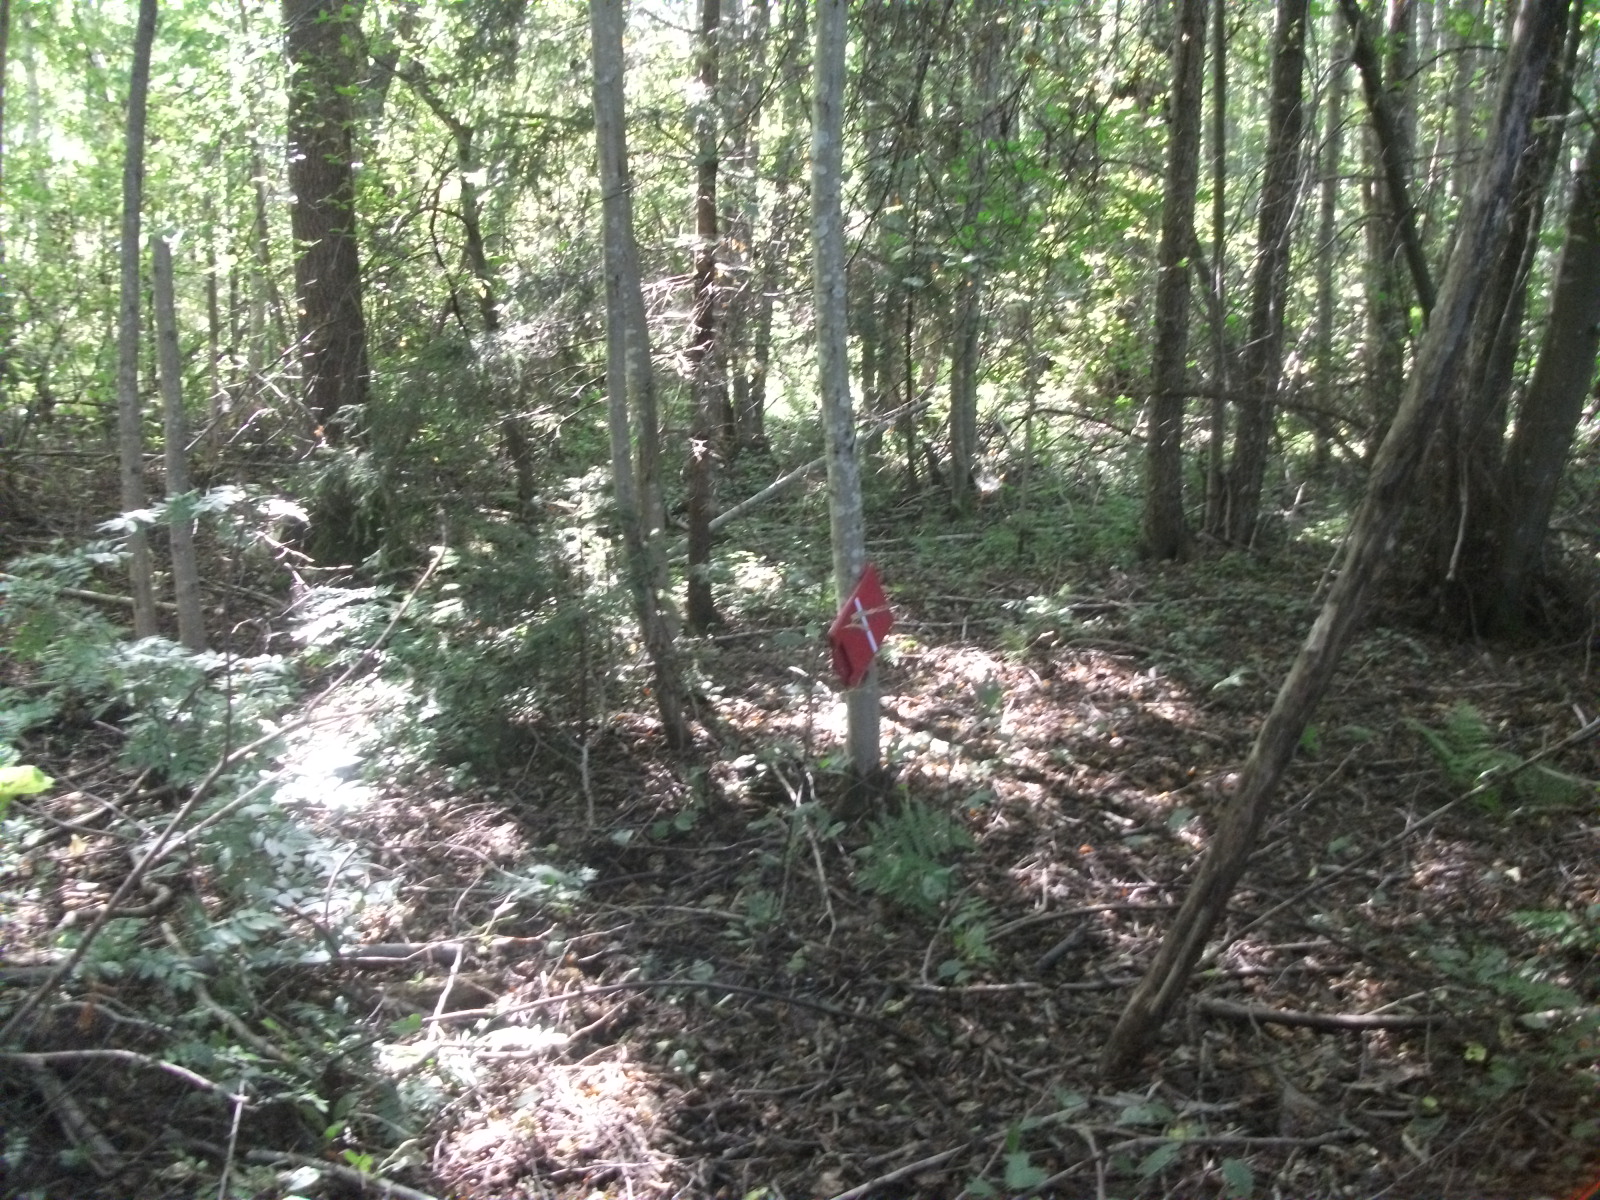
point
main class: Woodland
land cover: Broadleaved woodland
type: non-riverine alder, birch or aspen forest
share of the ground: > 75 %
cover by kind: broadleaved forest trees 95 %, shrubs 5 %
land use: Forestry
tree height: > 5 m
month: August
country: LV
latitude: 56.5237
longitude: 26.0823
